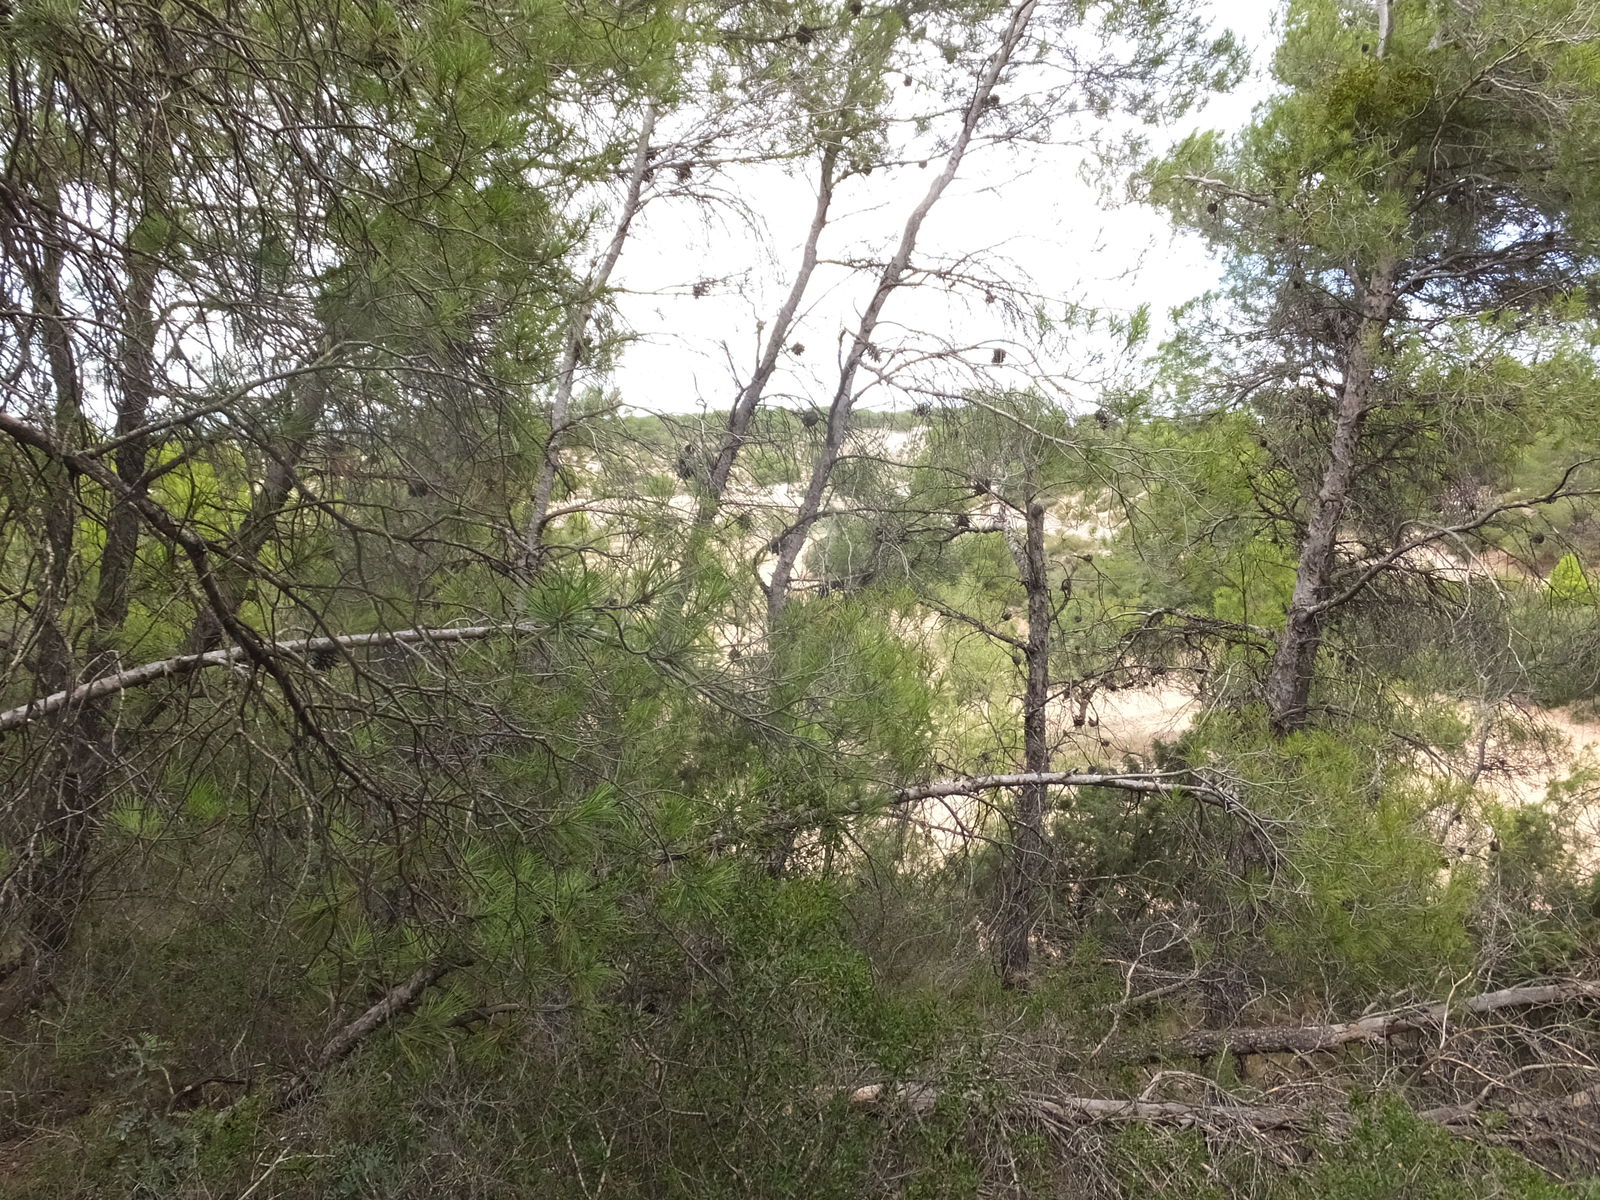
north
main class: Woodland
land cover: Pine dominated mixed woodland
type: coniferous forest of the mediterranean region
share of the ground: 50 - 75 %
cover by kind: coniferous forest trees 60 %, broadleaved forest trees 20 %, shrubs 15 %, herbaceous plants 5 %
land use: Forestry
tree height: > 5 m
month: August
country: ES
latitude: 41.3412
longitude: 0.2005
